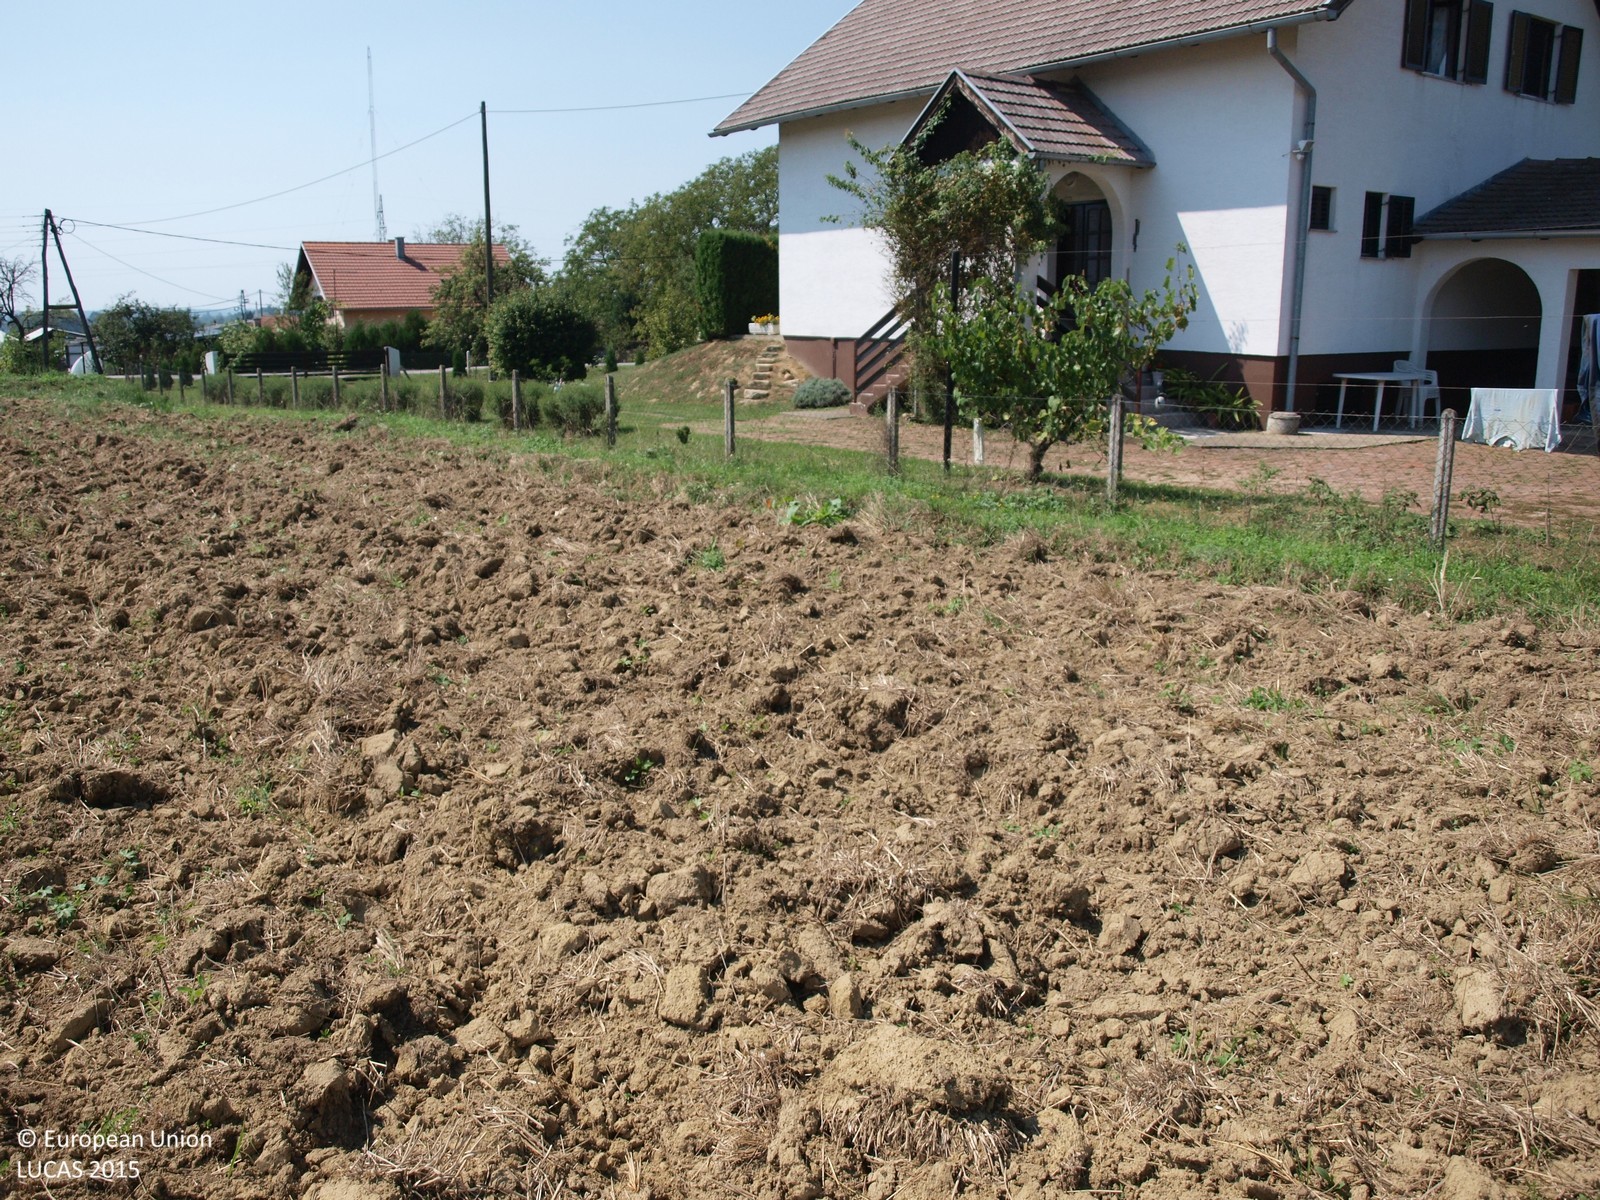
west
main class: Cropland
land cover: Common wheat
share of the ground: > 75 %
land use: Agriculture (excluding fallow land and kitchen gardens)
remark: Harvested field
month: August
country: HR
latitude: 45.7026
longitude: 16.4849
